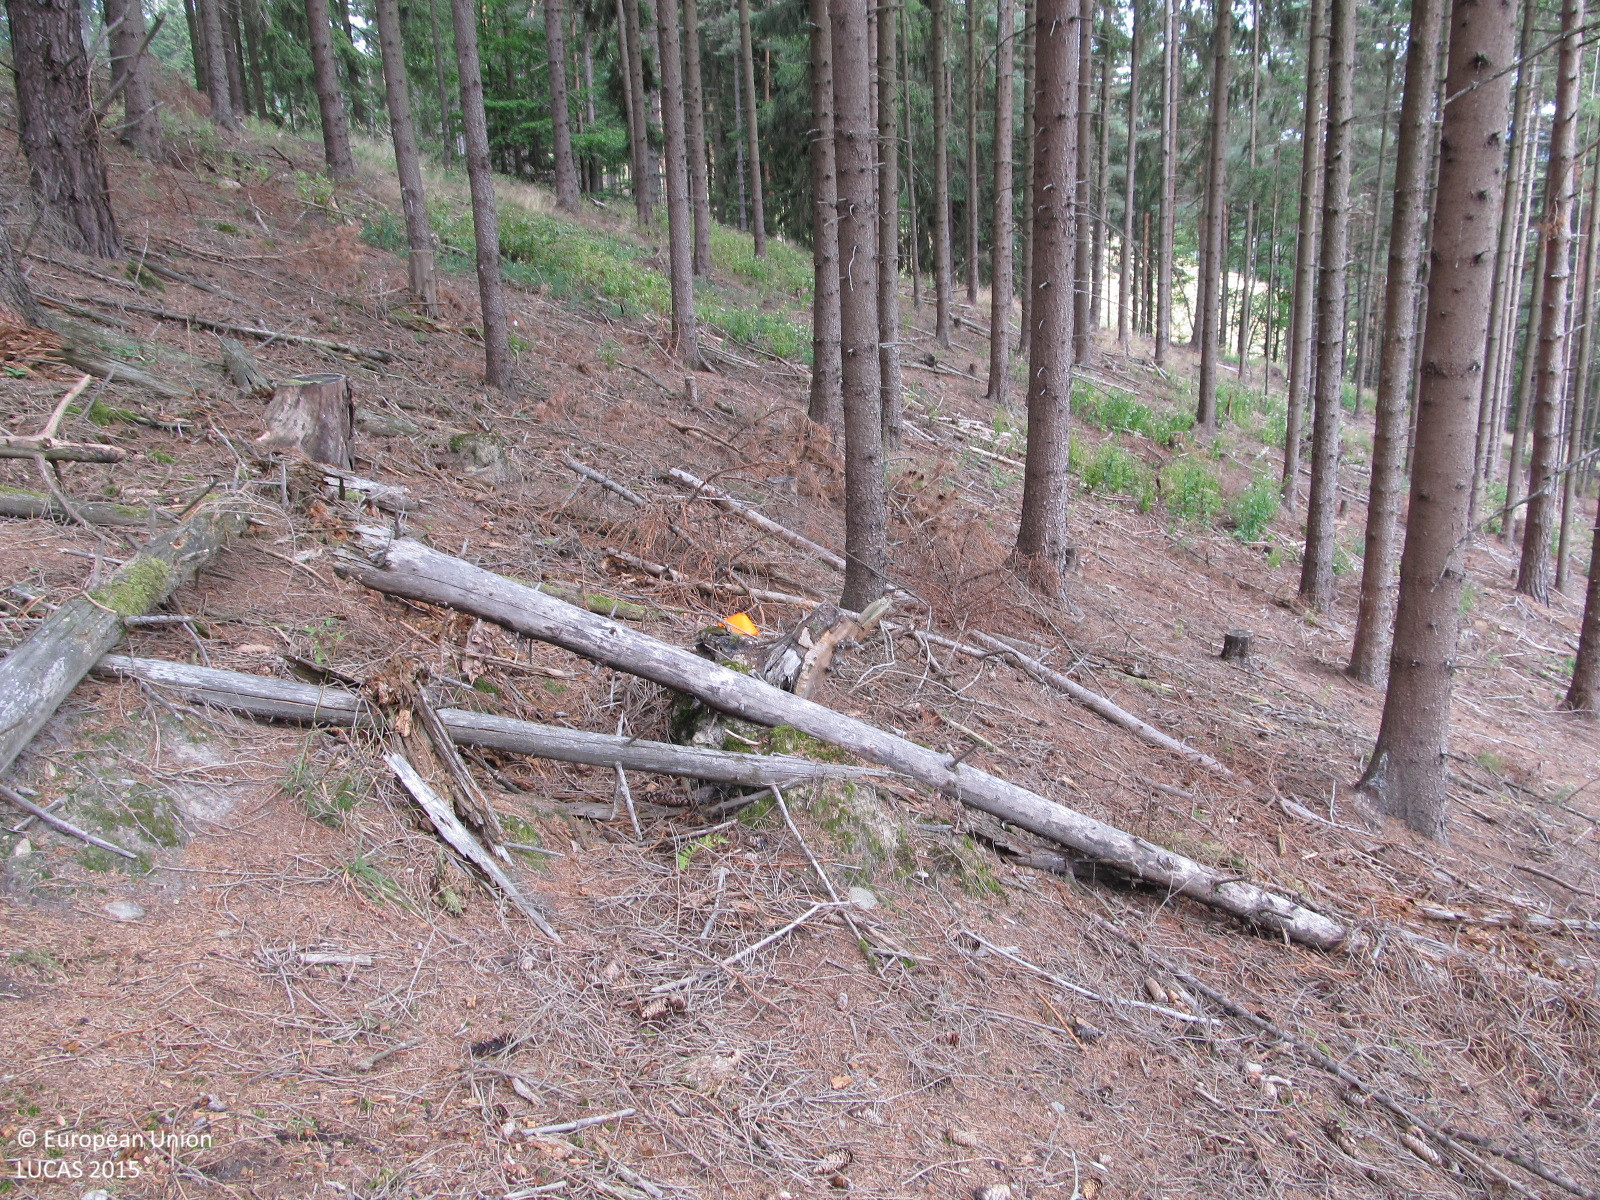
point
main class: Woodland
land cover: Spruce dominated coniferous woodland
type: hemiboreal forest and nemoral coniferous forest and mixed broadleaved-coniferous forest
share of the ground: > 75 %
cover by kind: coniferous forest trees 80 %, unconsolidated bare surface 20 %
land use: Forestry
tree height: > 5 m
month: September
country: AT
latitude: 48.3404
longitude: 15.4665
